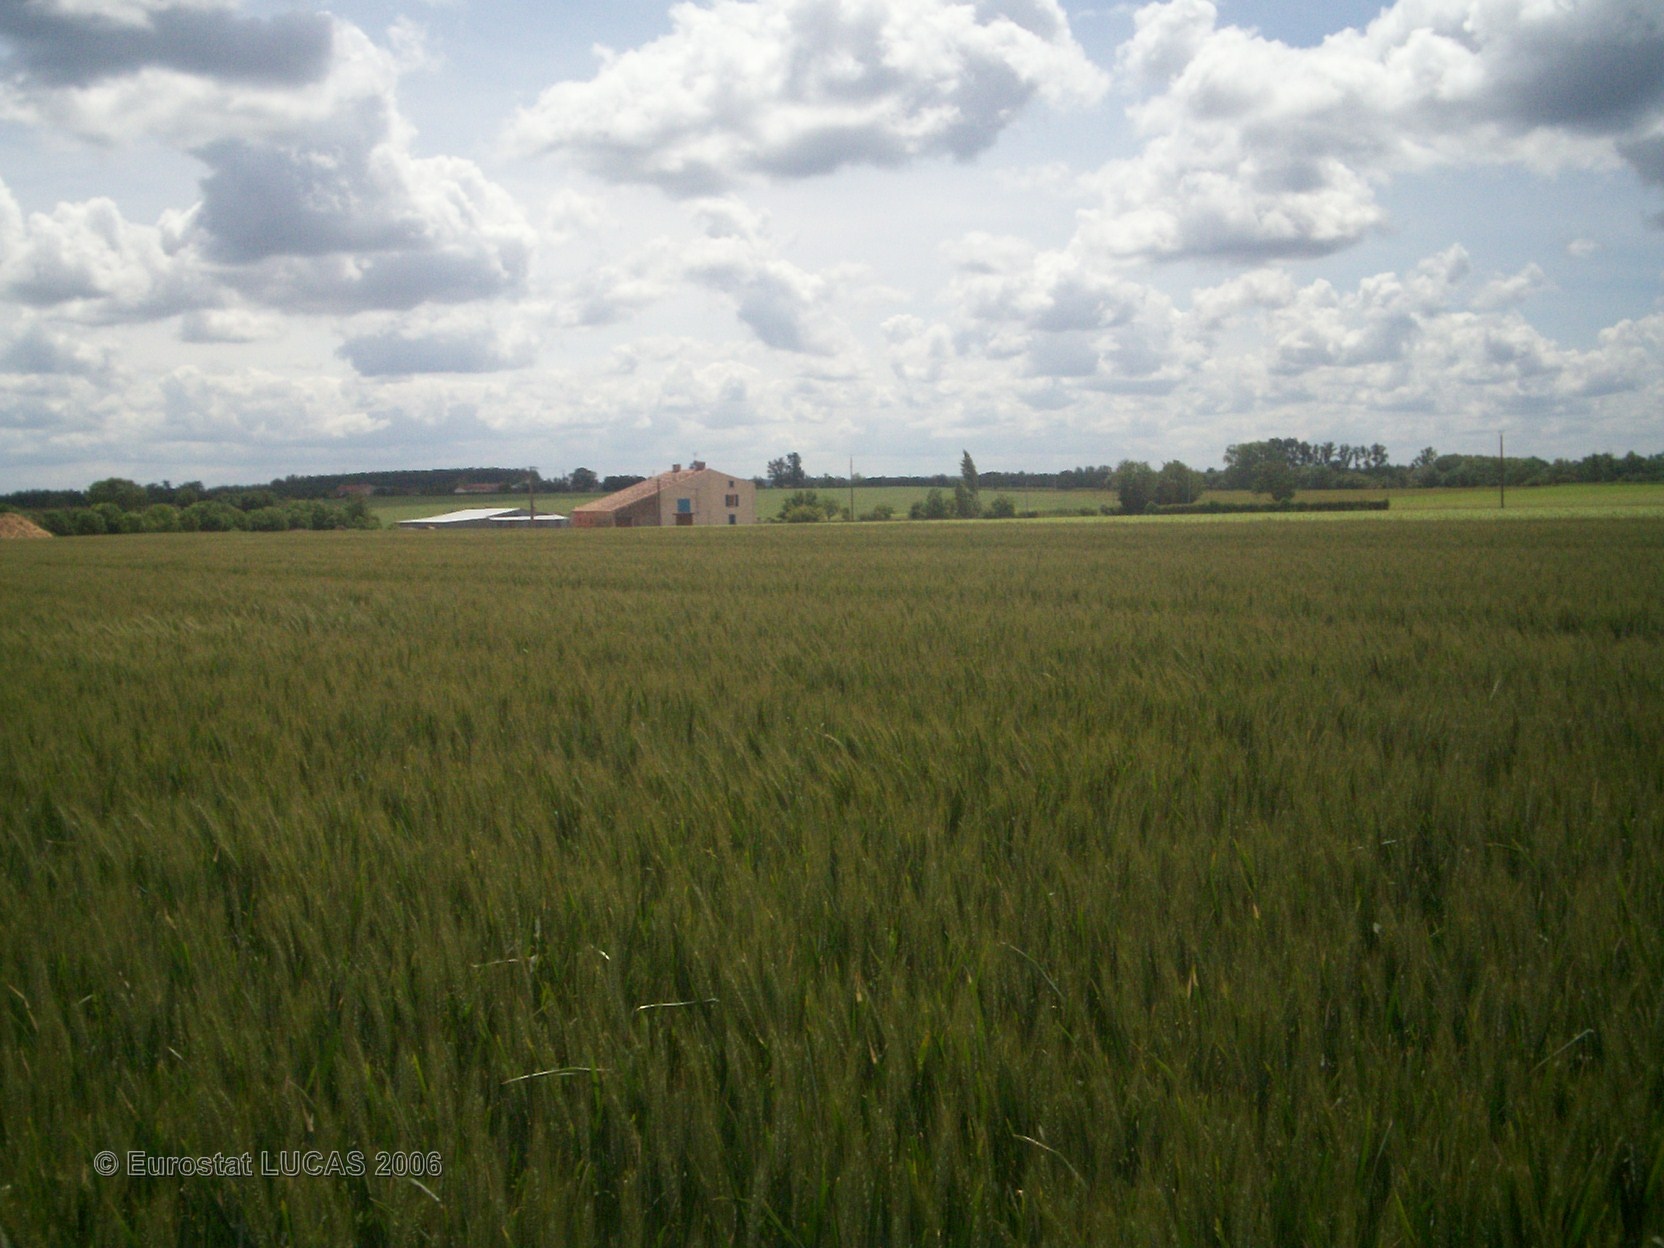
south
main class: Cropland
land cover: Common wheat
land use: Agriculture (excluding fallow land and kitchen gardens)
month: May
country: FR
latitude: 46.3528
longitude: -0.7495
